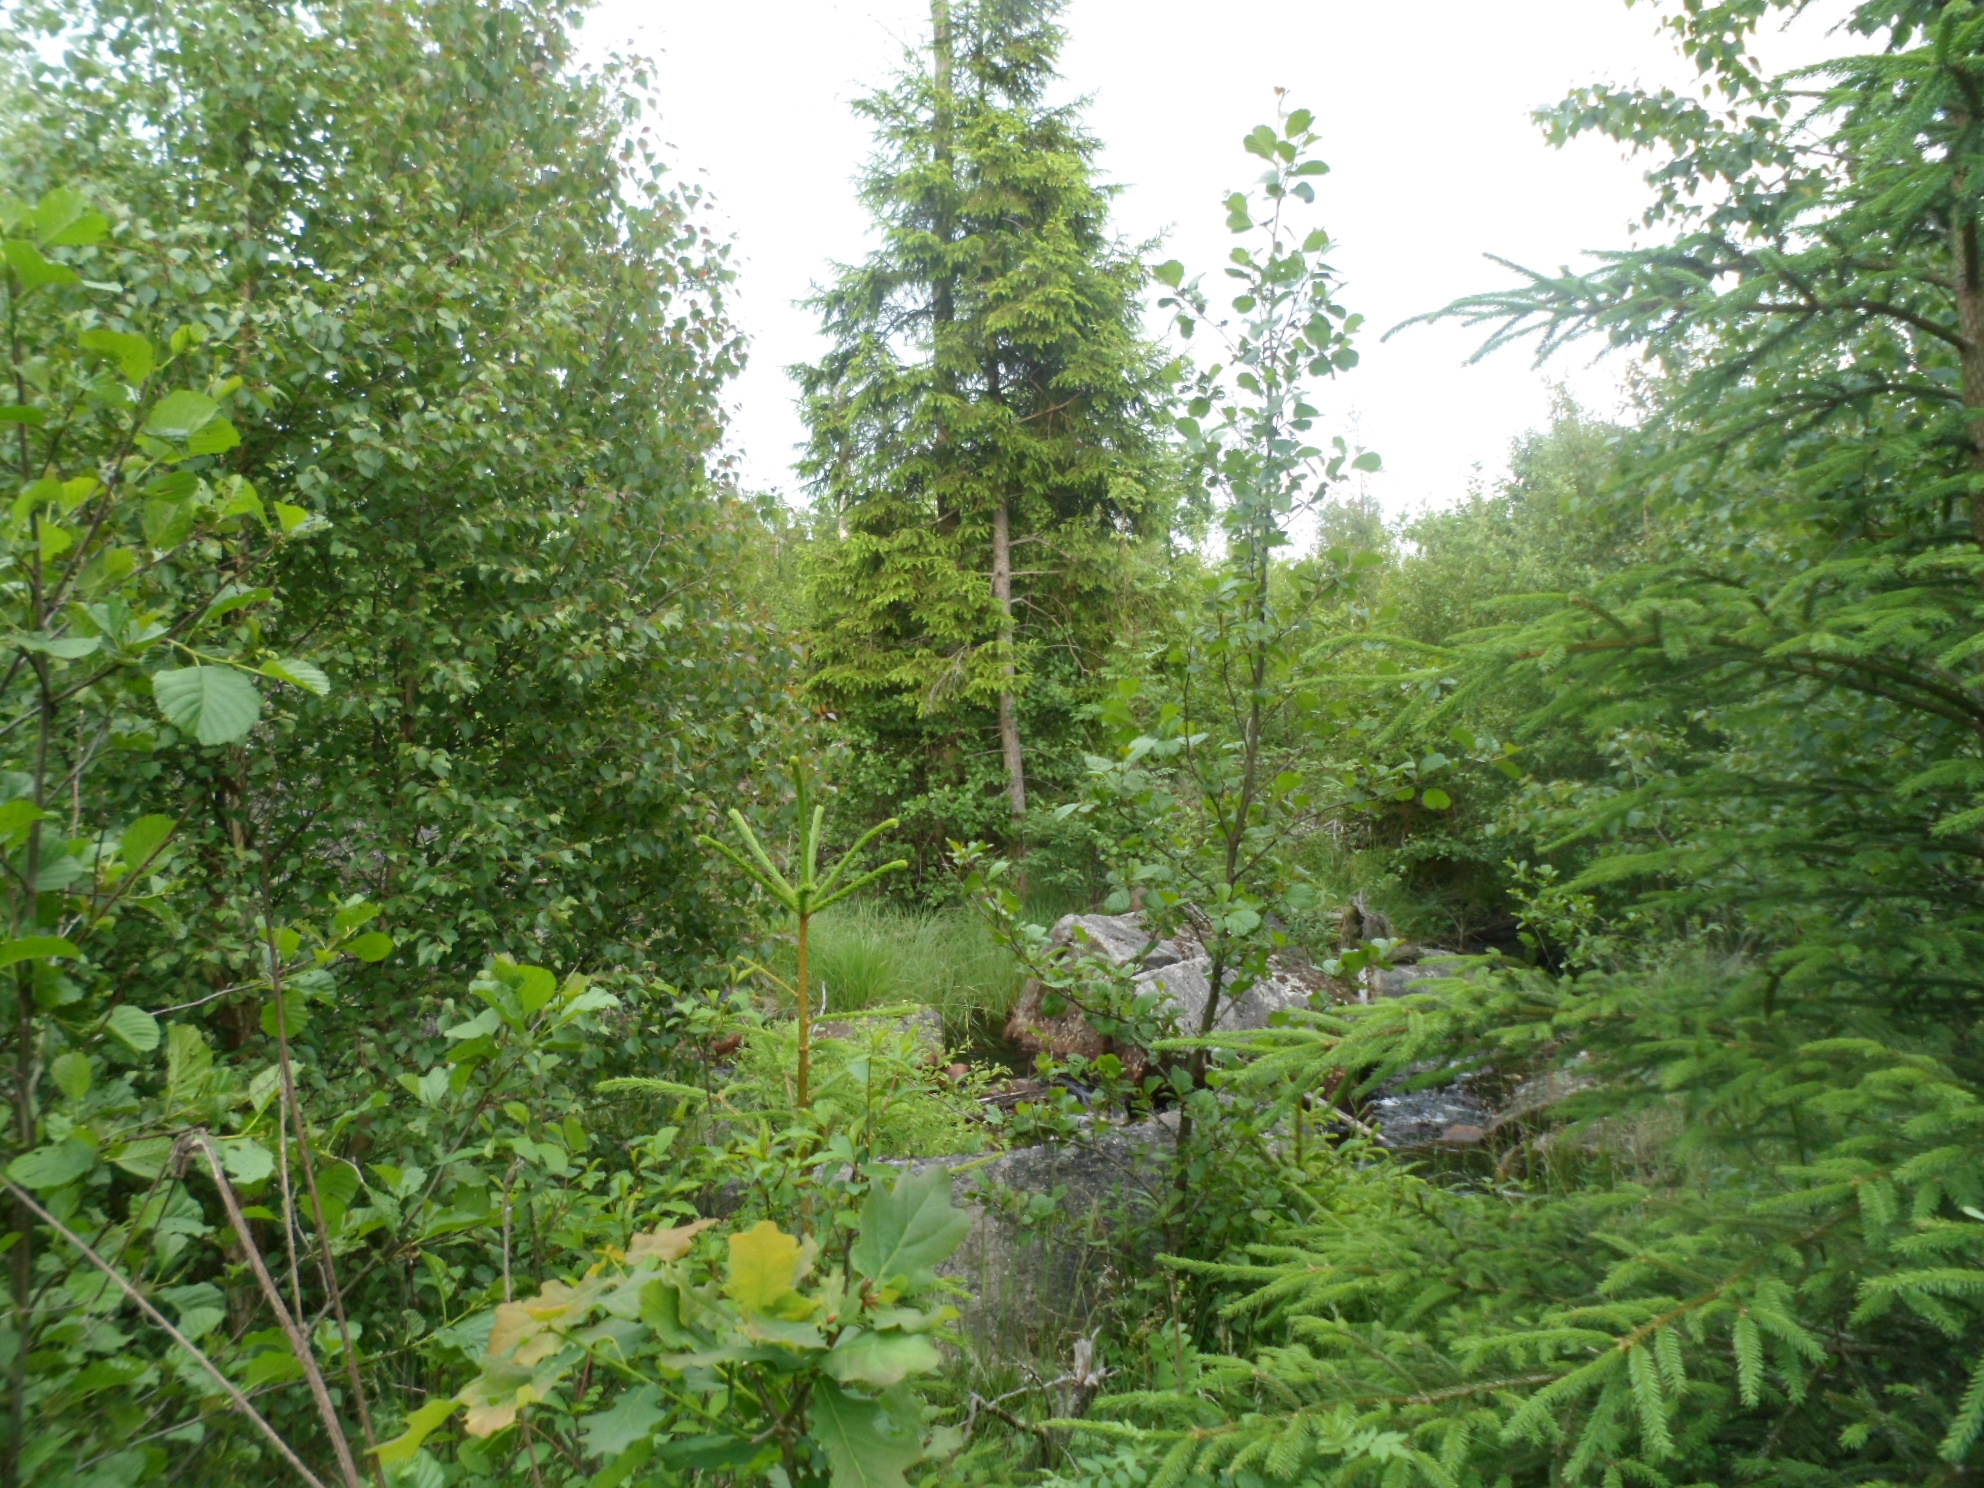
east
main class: Woodland
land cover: Spruce dominated mixed woodland
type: boreal forest
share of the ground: > 75 %
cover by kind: broadleaved forest trees 45 %, coniferous forest trees 35 %, herbaceous plants 15 %, shrubs 5 %
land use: Forestry
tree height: < 5 m
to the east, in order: Spruce dominated mixed woodland; Rivers and streams; Spruce dominated mixed woodland; Shrubland with sparse tree cover; Railways; Grassland with sparse tree/shrub cover; Tracks; Grassland with sparse tree/shrub cover; Spruce dominated coniferous woodland
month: June
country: SE
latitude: 57.0912
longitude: 14.2046
